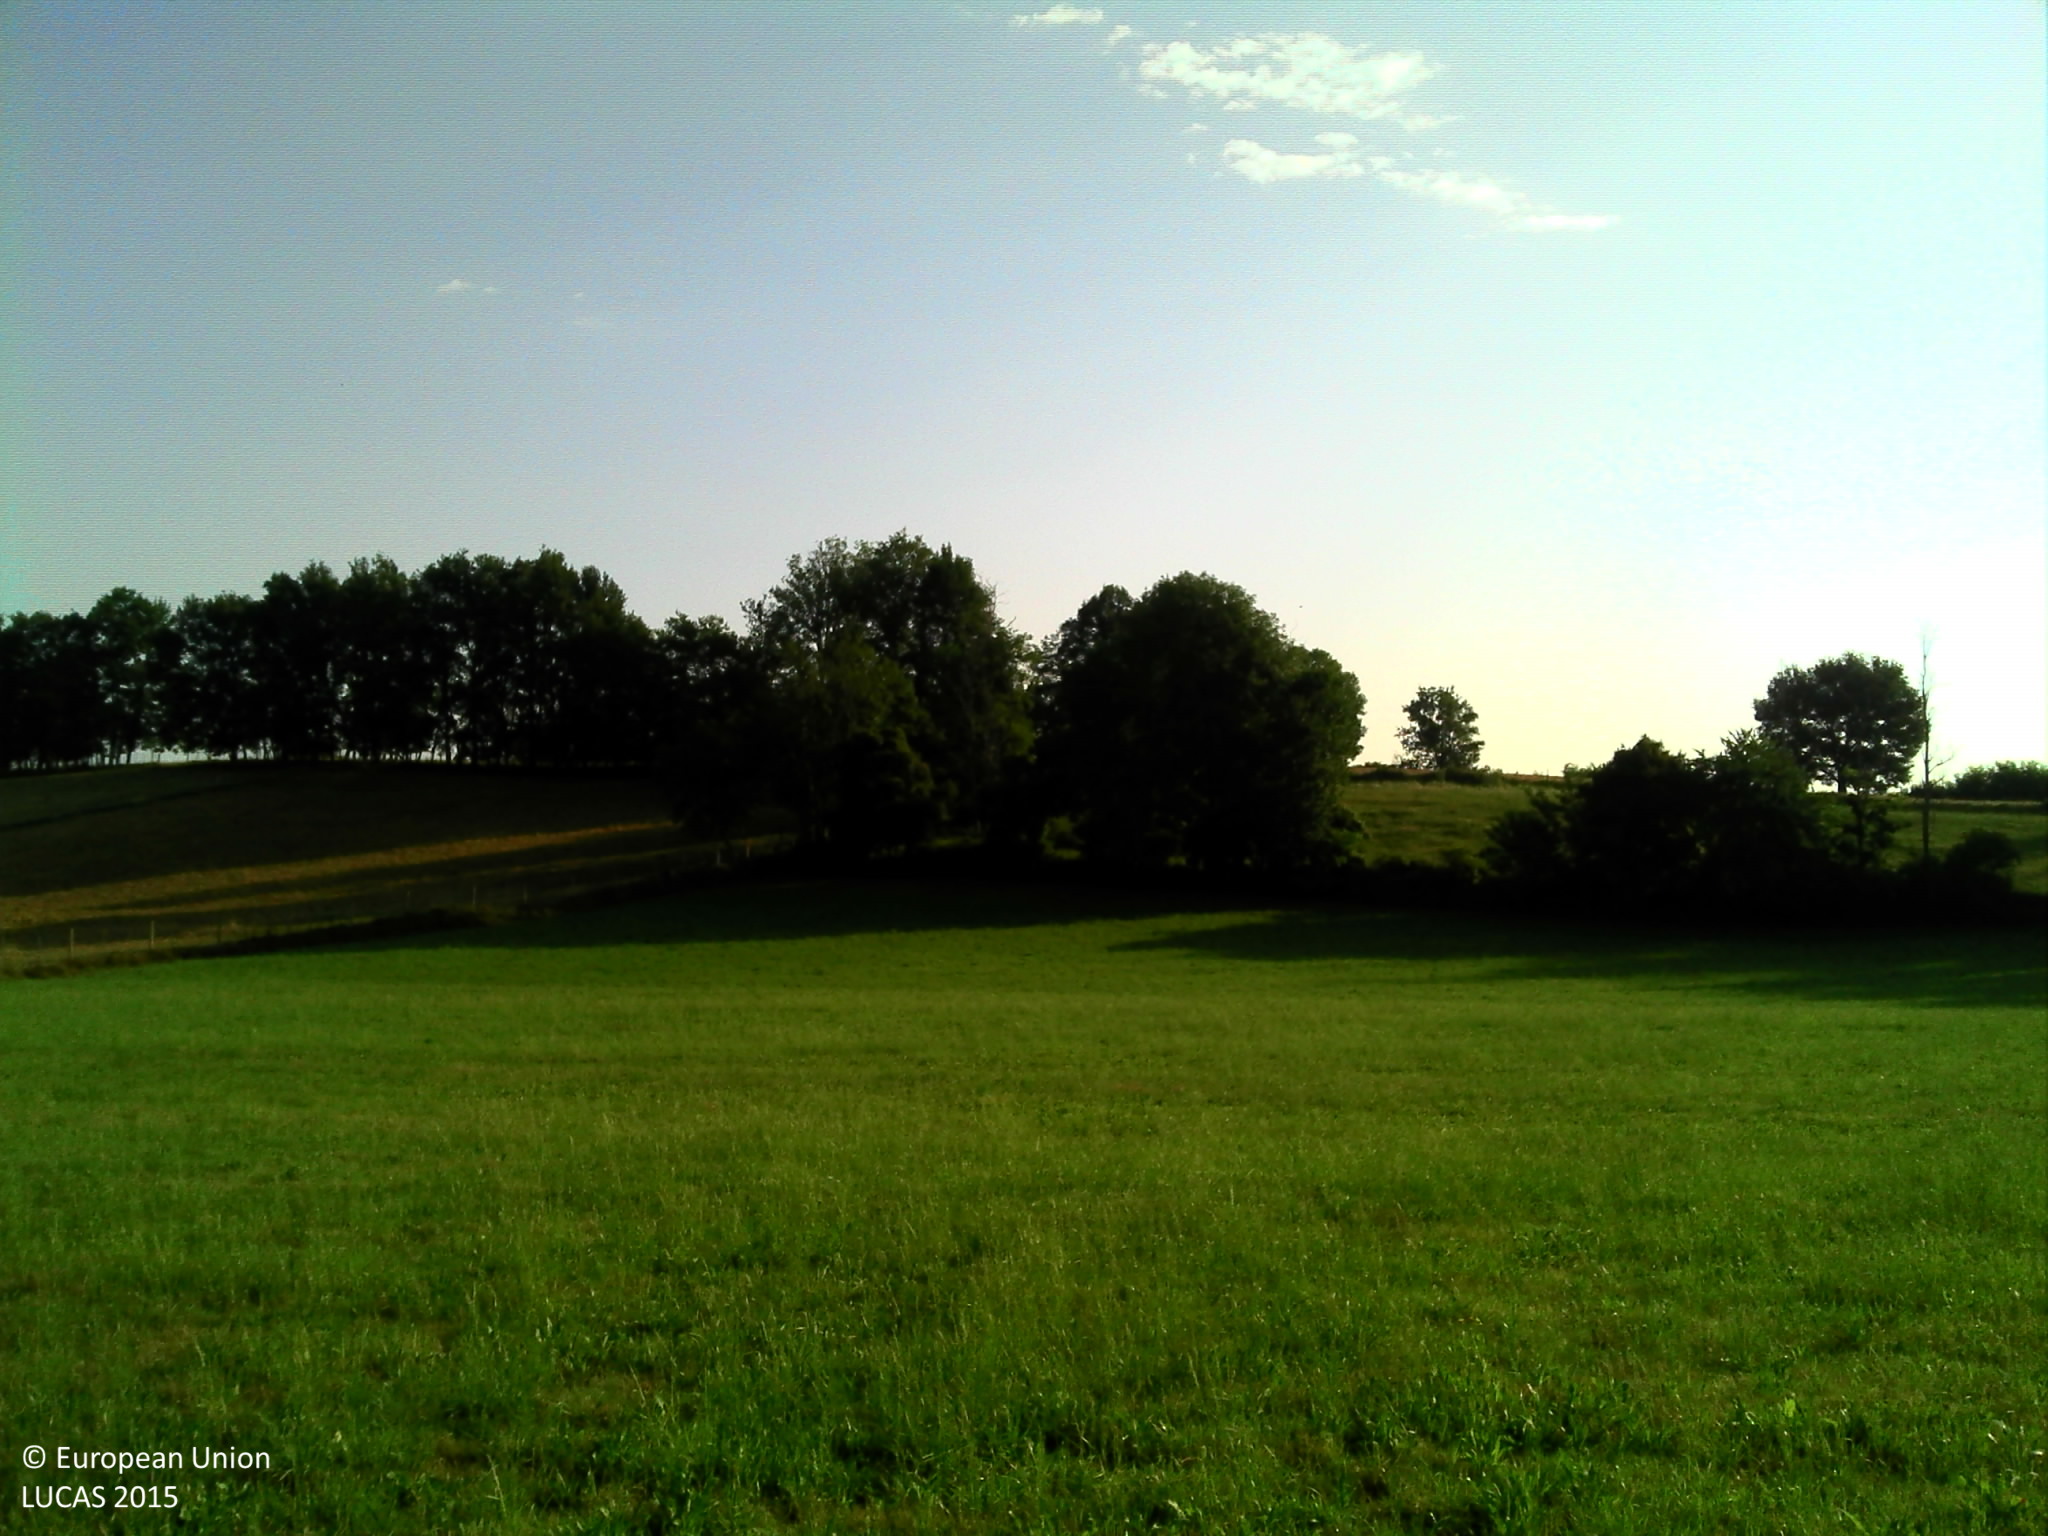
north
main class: Grassland
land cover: Grassland without tree/shrub cover
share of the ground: > 75 %
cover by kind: herbaceous plants 100 %
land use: Agriculture (excluding fallow land and kitchen gardens)
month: July
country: FR
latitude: 42.9731
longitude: 1.1399
